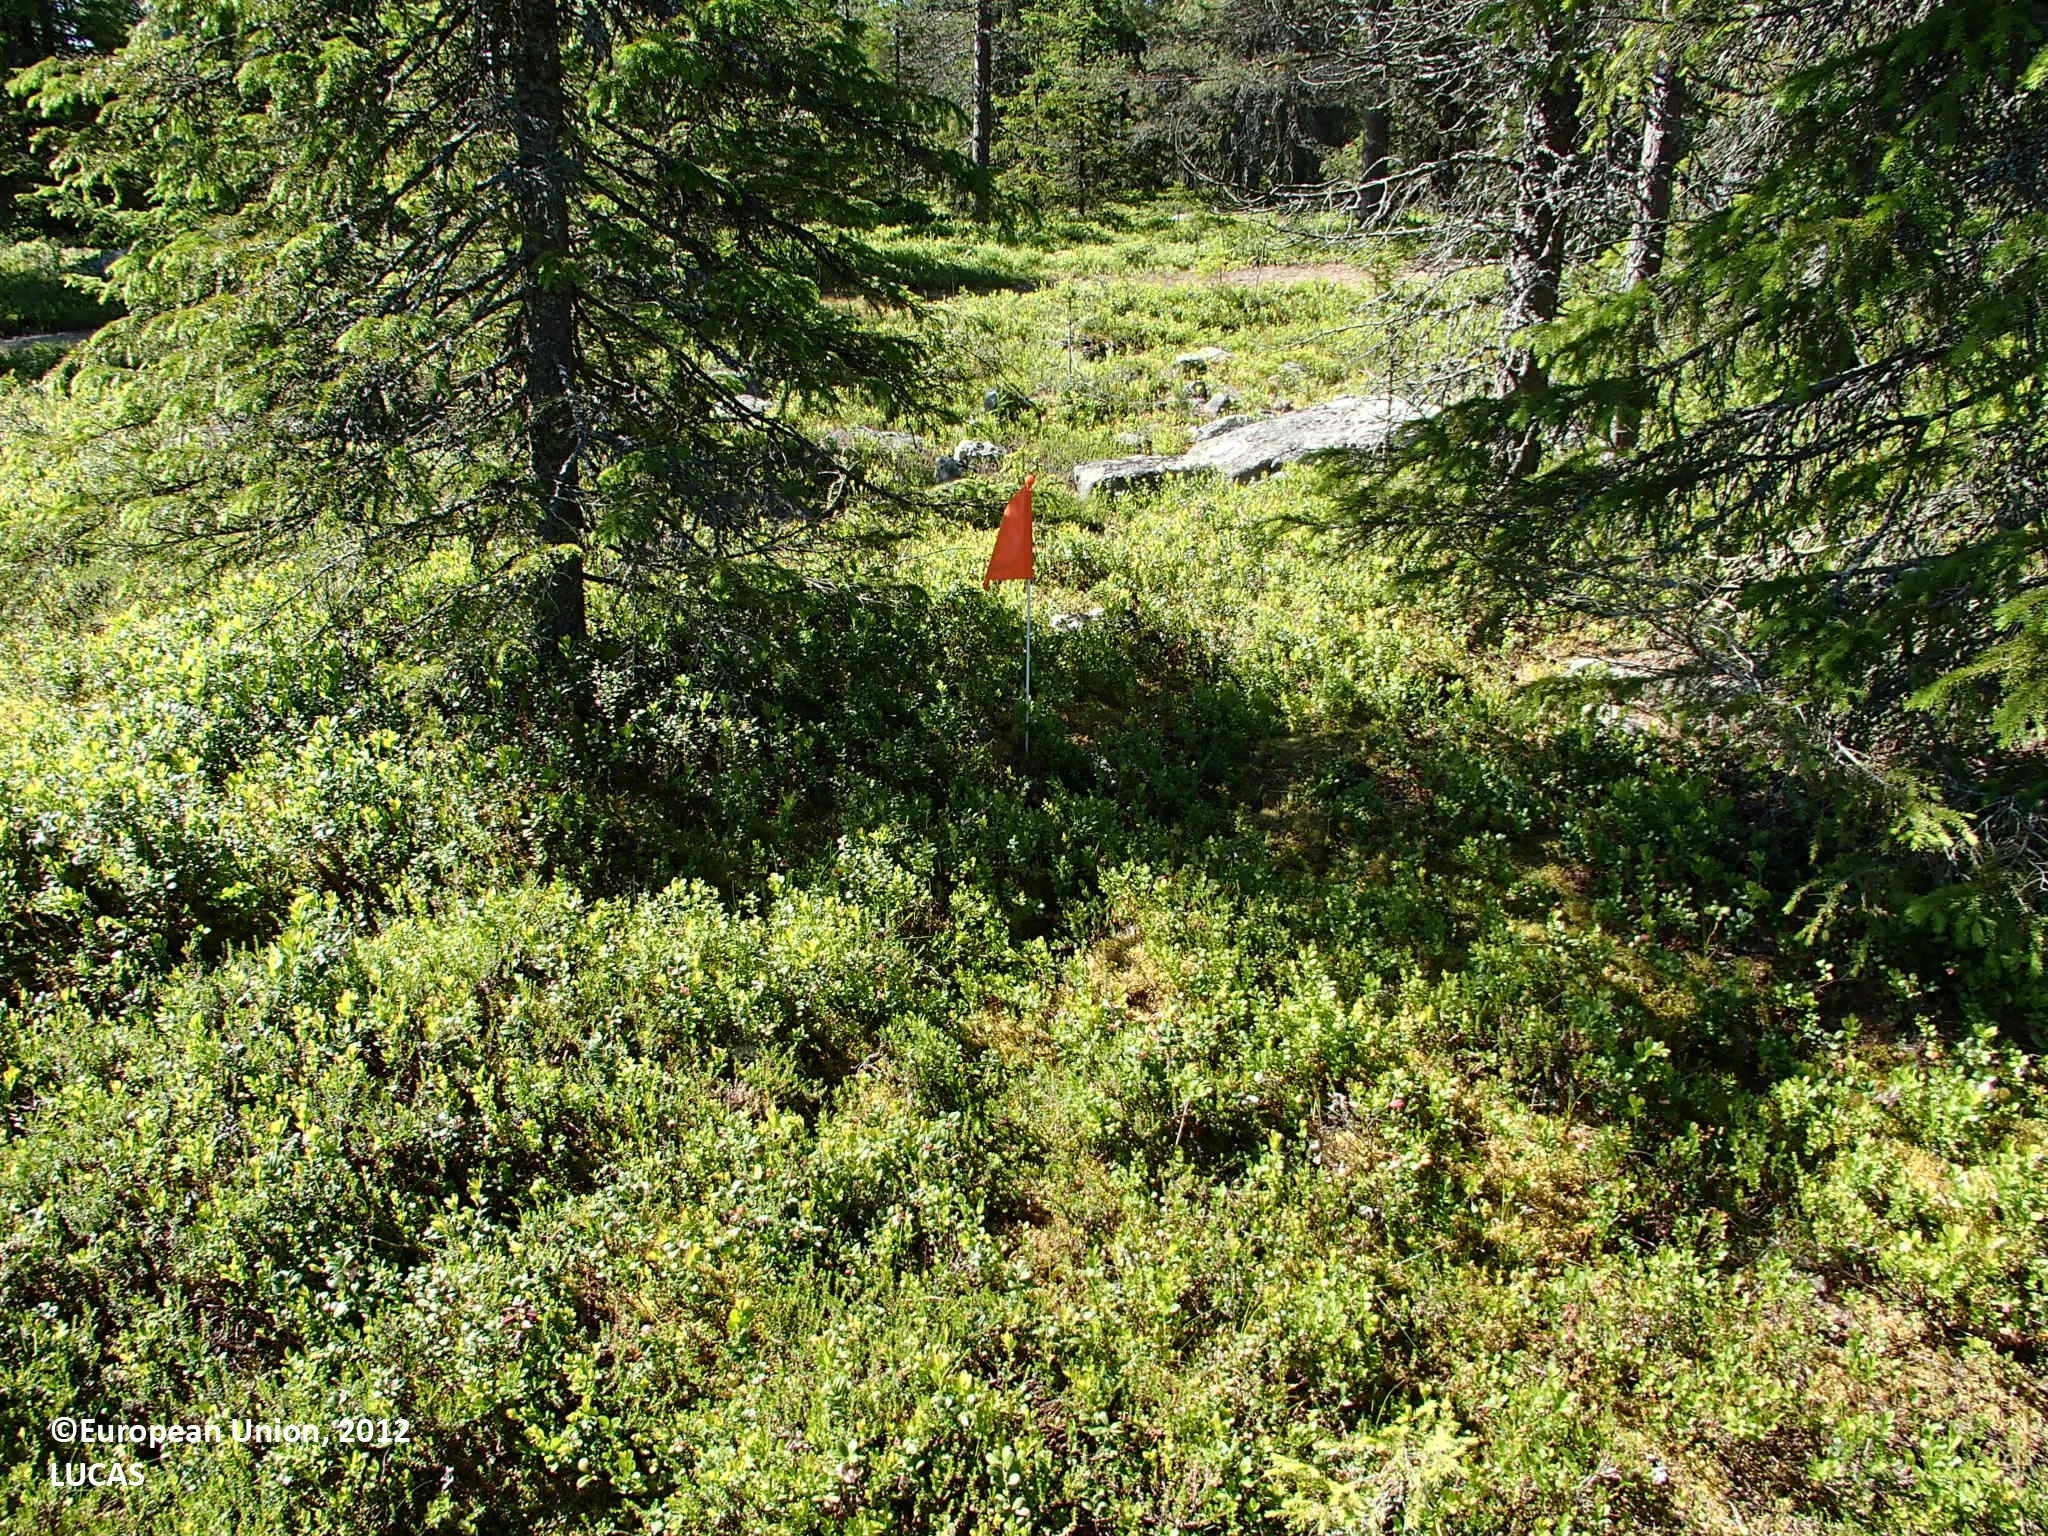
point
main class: Woodland
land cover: Other coniferous woodland
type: boreal forest
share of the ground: > 75 %
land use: Forestry
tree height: > 5 m
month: July
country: FI
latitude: 67.3405
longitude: 26.0431
